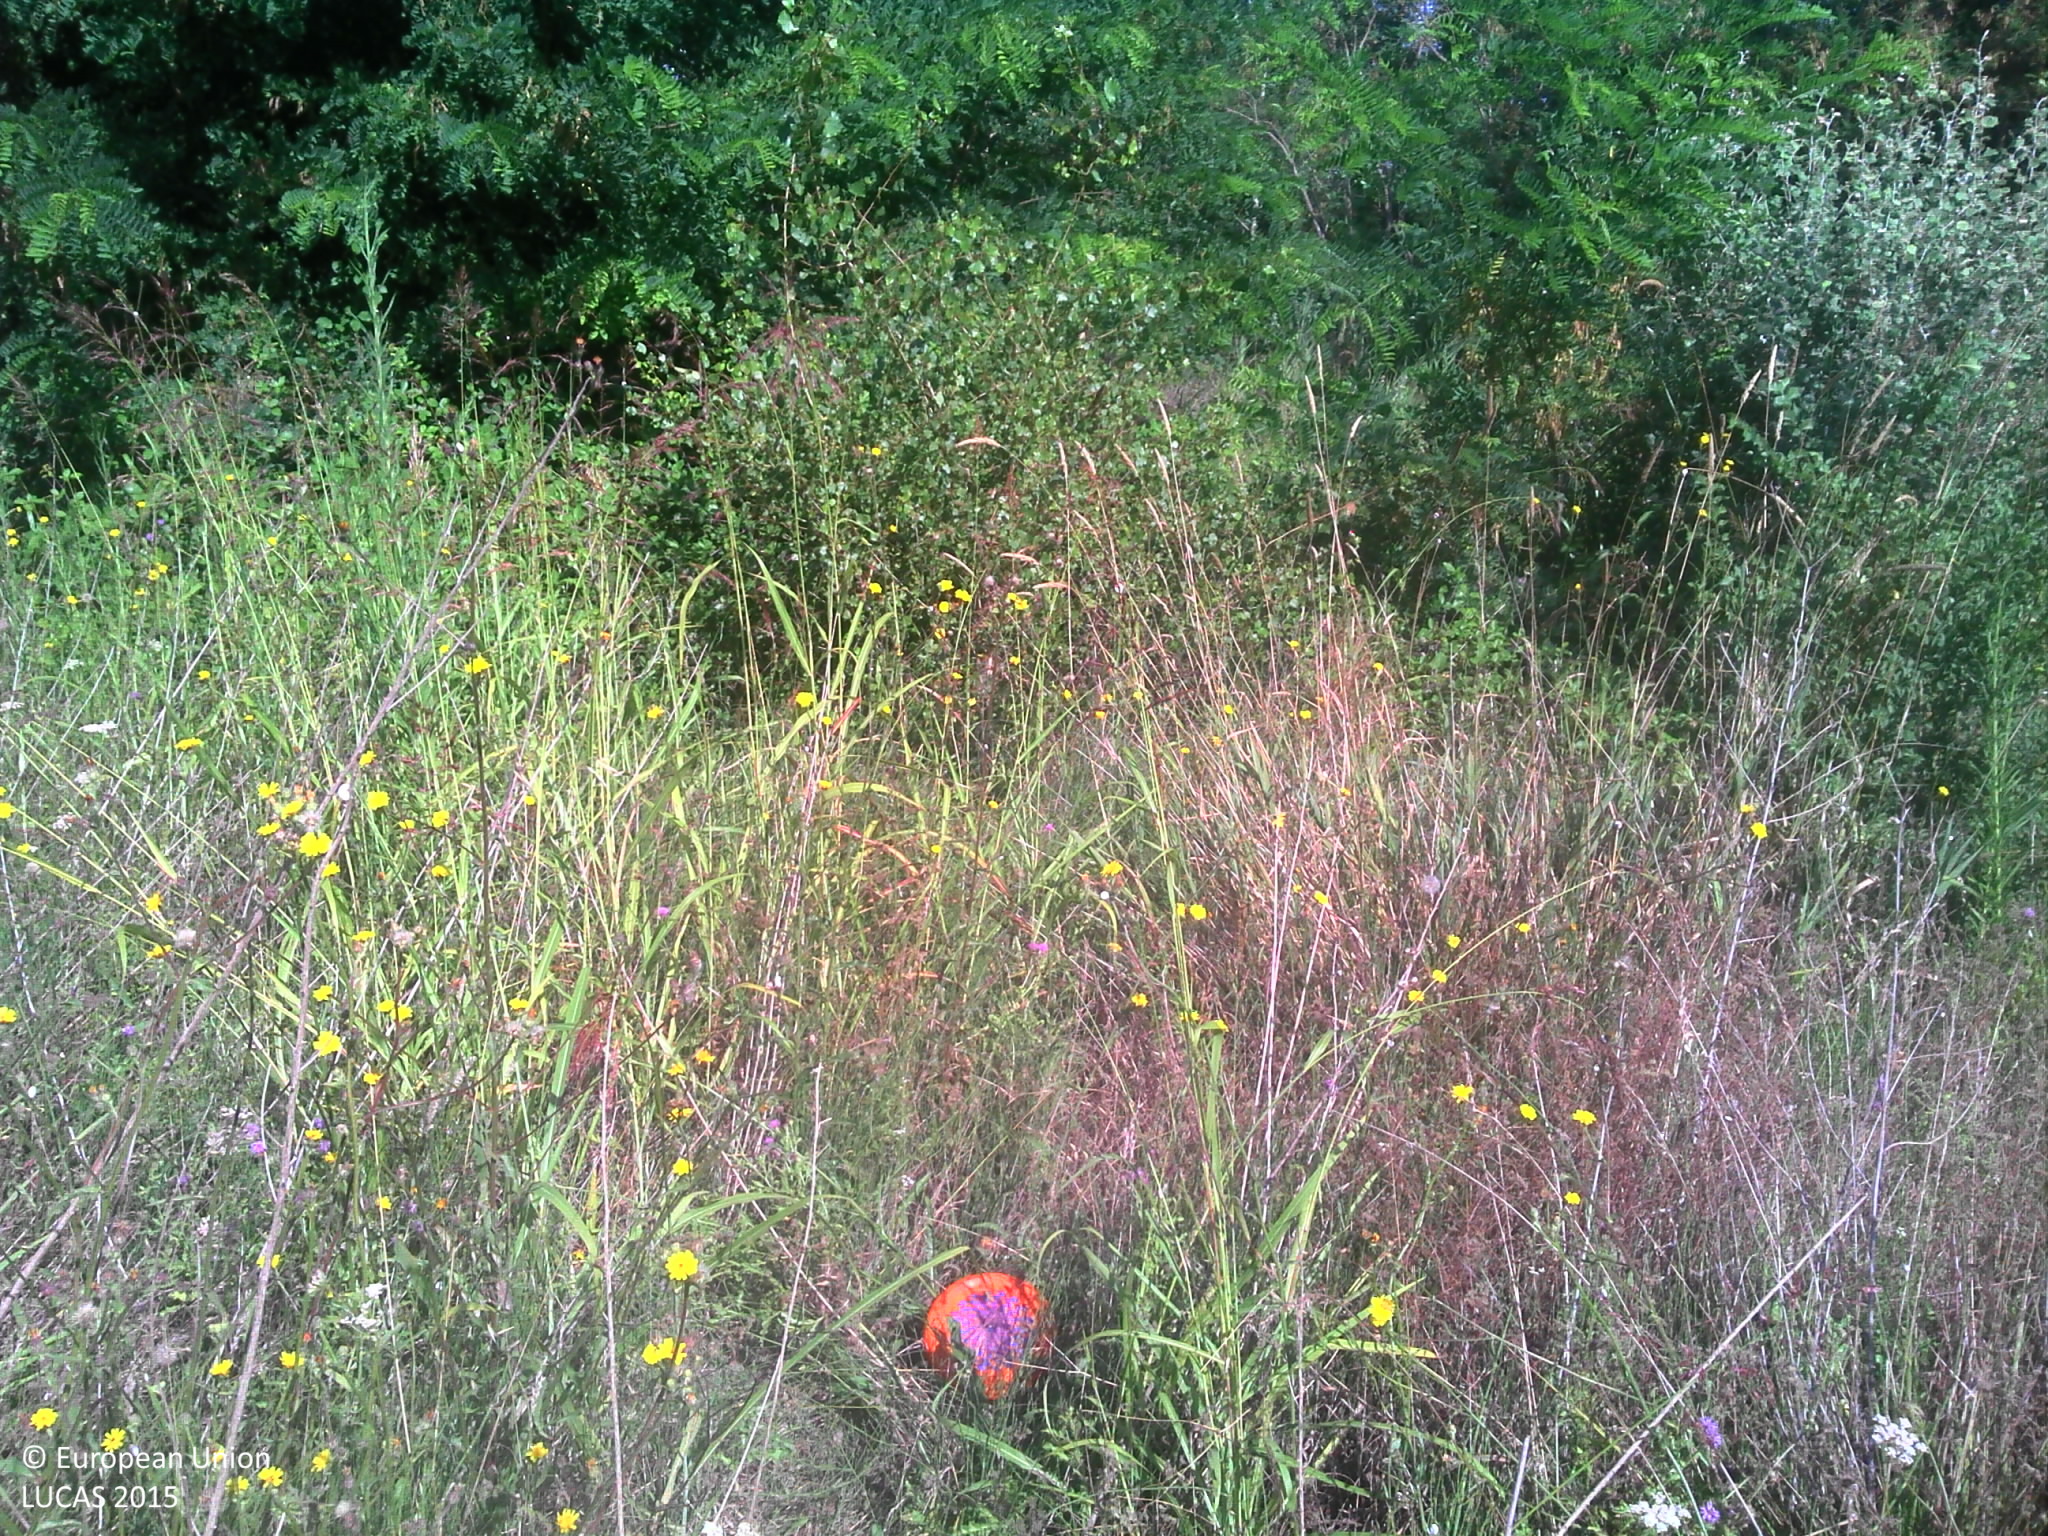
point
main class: Grassland
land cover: Grassland with sparse tree/shrub cover
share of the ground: > 75 %
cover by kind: herbaceous plants 85 %, broadleaved forest trees 5 %, shrubs 5 %, consolidated bare surface 5 %
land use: Fallow land
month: July
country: FR
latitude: 43.7372
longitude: 5.2786
